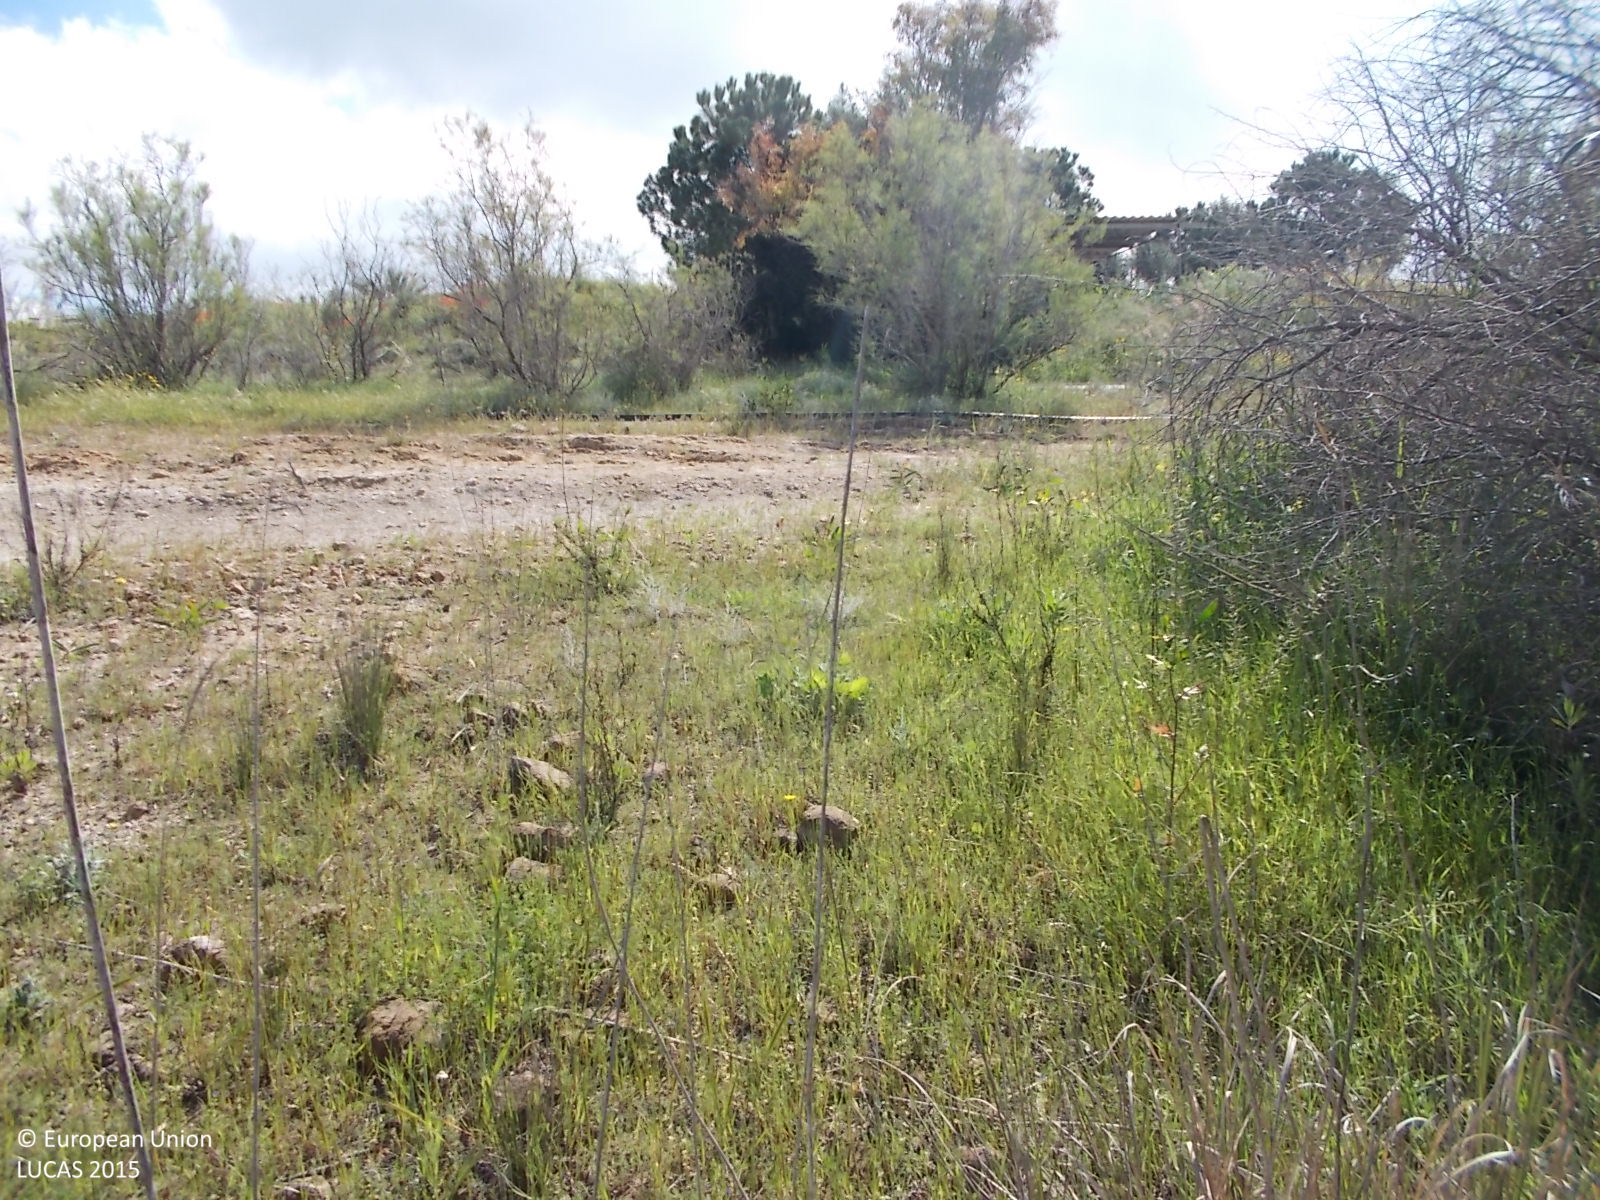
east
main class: Grassland
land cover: Grassland with sparse tree/shrub cover
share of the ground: > 75 %
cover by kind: herbaceous plants 95 %, broadleaved forest trees 5 %
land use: Semi-natural and natural areas not in use
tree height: < 5 m
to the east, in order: Grassland with sparse tree/shrub cover; Tracks; Other mixed woodland; Spontaneously vegetated surfaces; Fences; Spontaneously vegetated surfaces; Paved roads, cycling and walking lanes; Shrubland without tree cover; Common wheat; Electric lines; Paved roads, cycling and walking lanes; Abandoned hedges; Other fresh vegetables; Barley
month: April
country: CY
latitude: 35.0516
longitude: 33.8136
